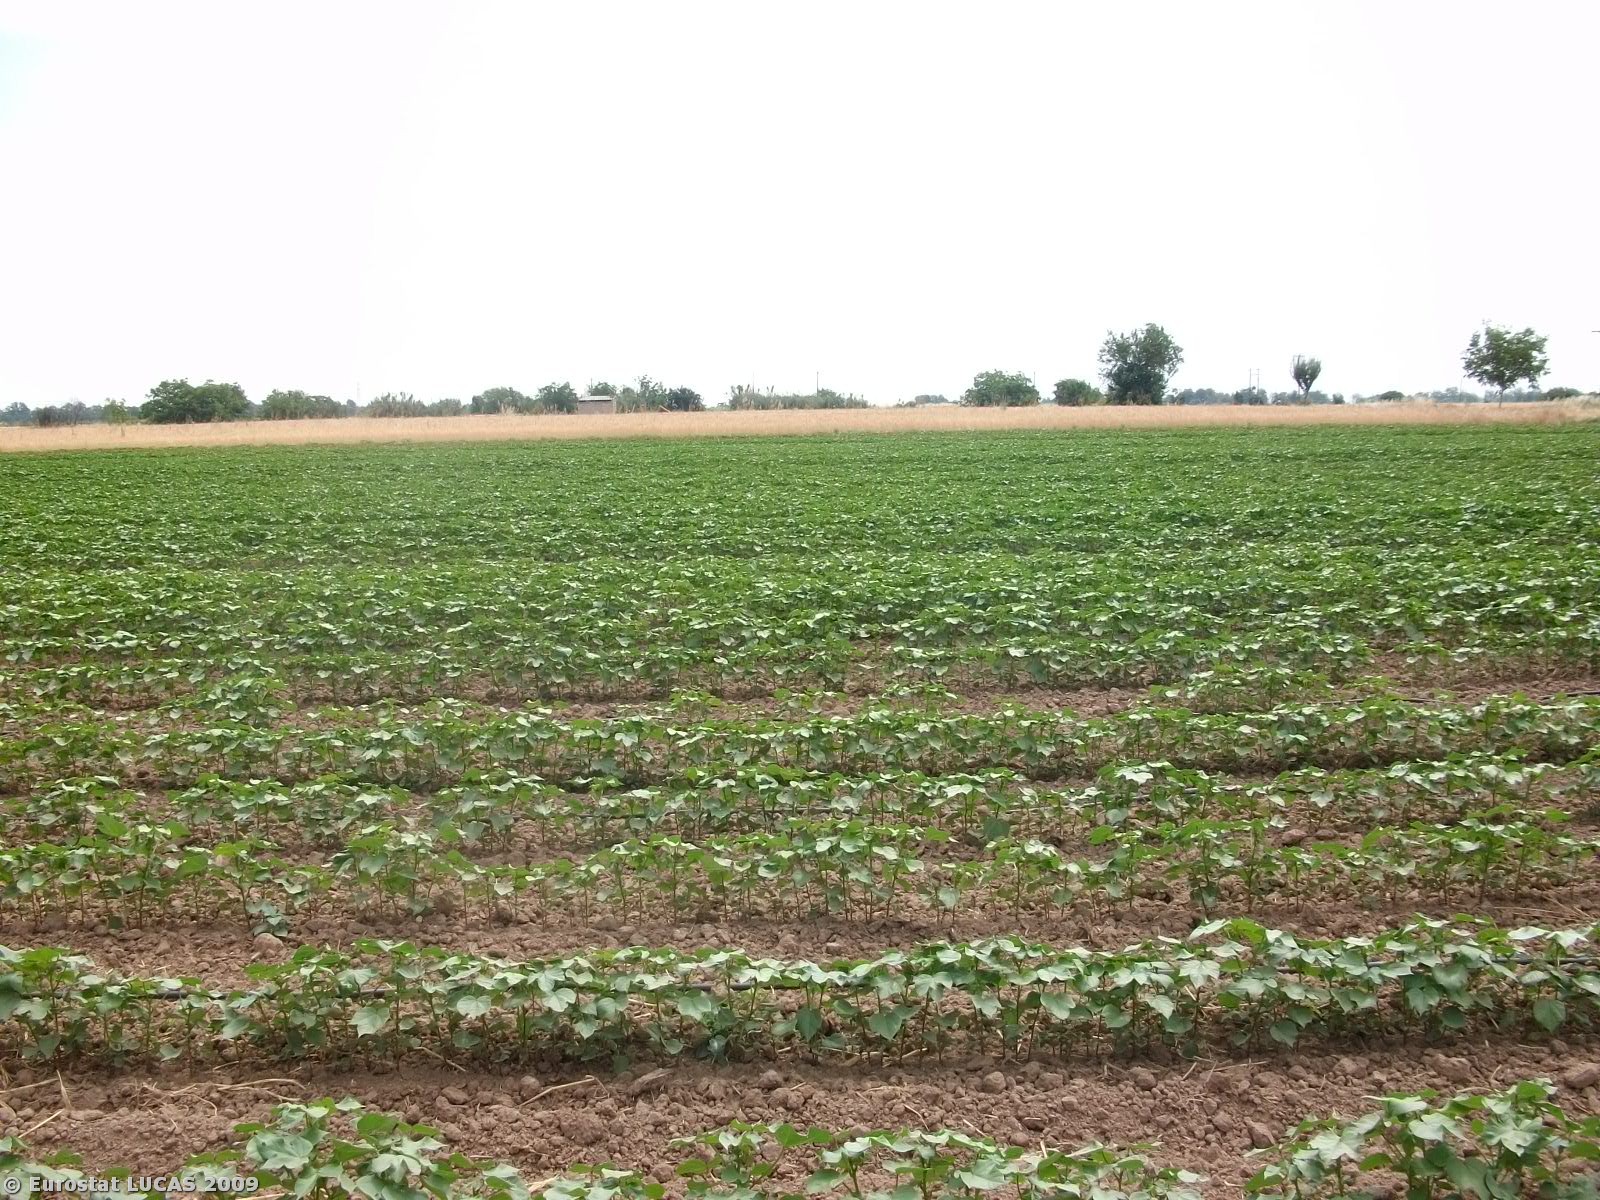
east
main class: Cropland
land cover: Cotton
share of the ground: 50 - 75 %
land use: Agriculture (excluding fallow land and kitchen gardens)
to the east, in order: Cotton; Durum wheat; Grass margins; Tracks; Grass margins; Durum wheat
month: June
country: GR
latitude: 39.2803
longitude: 21.9333
